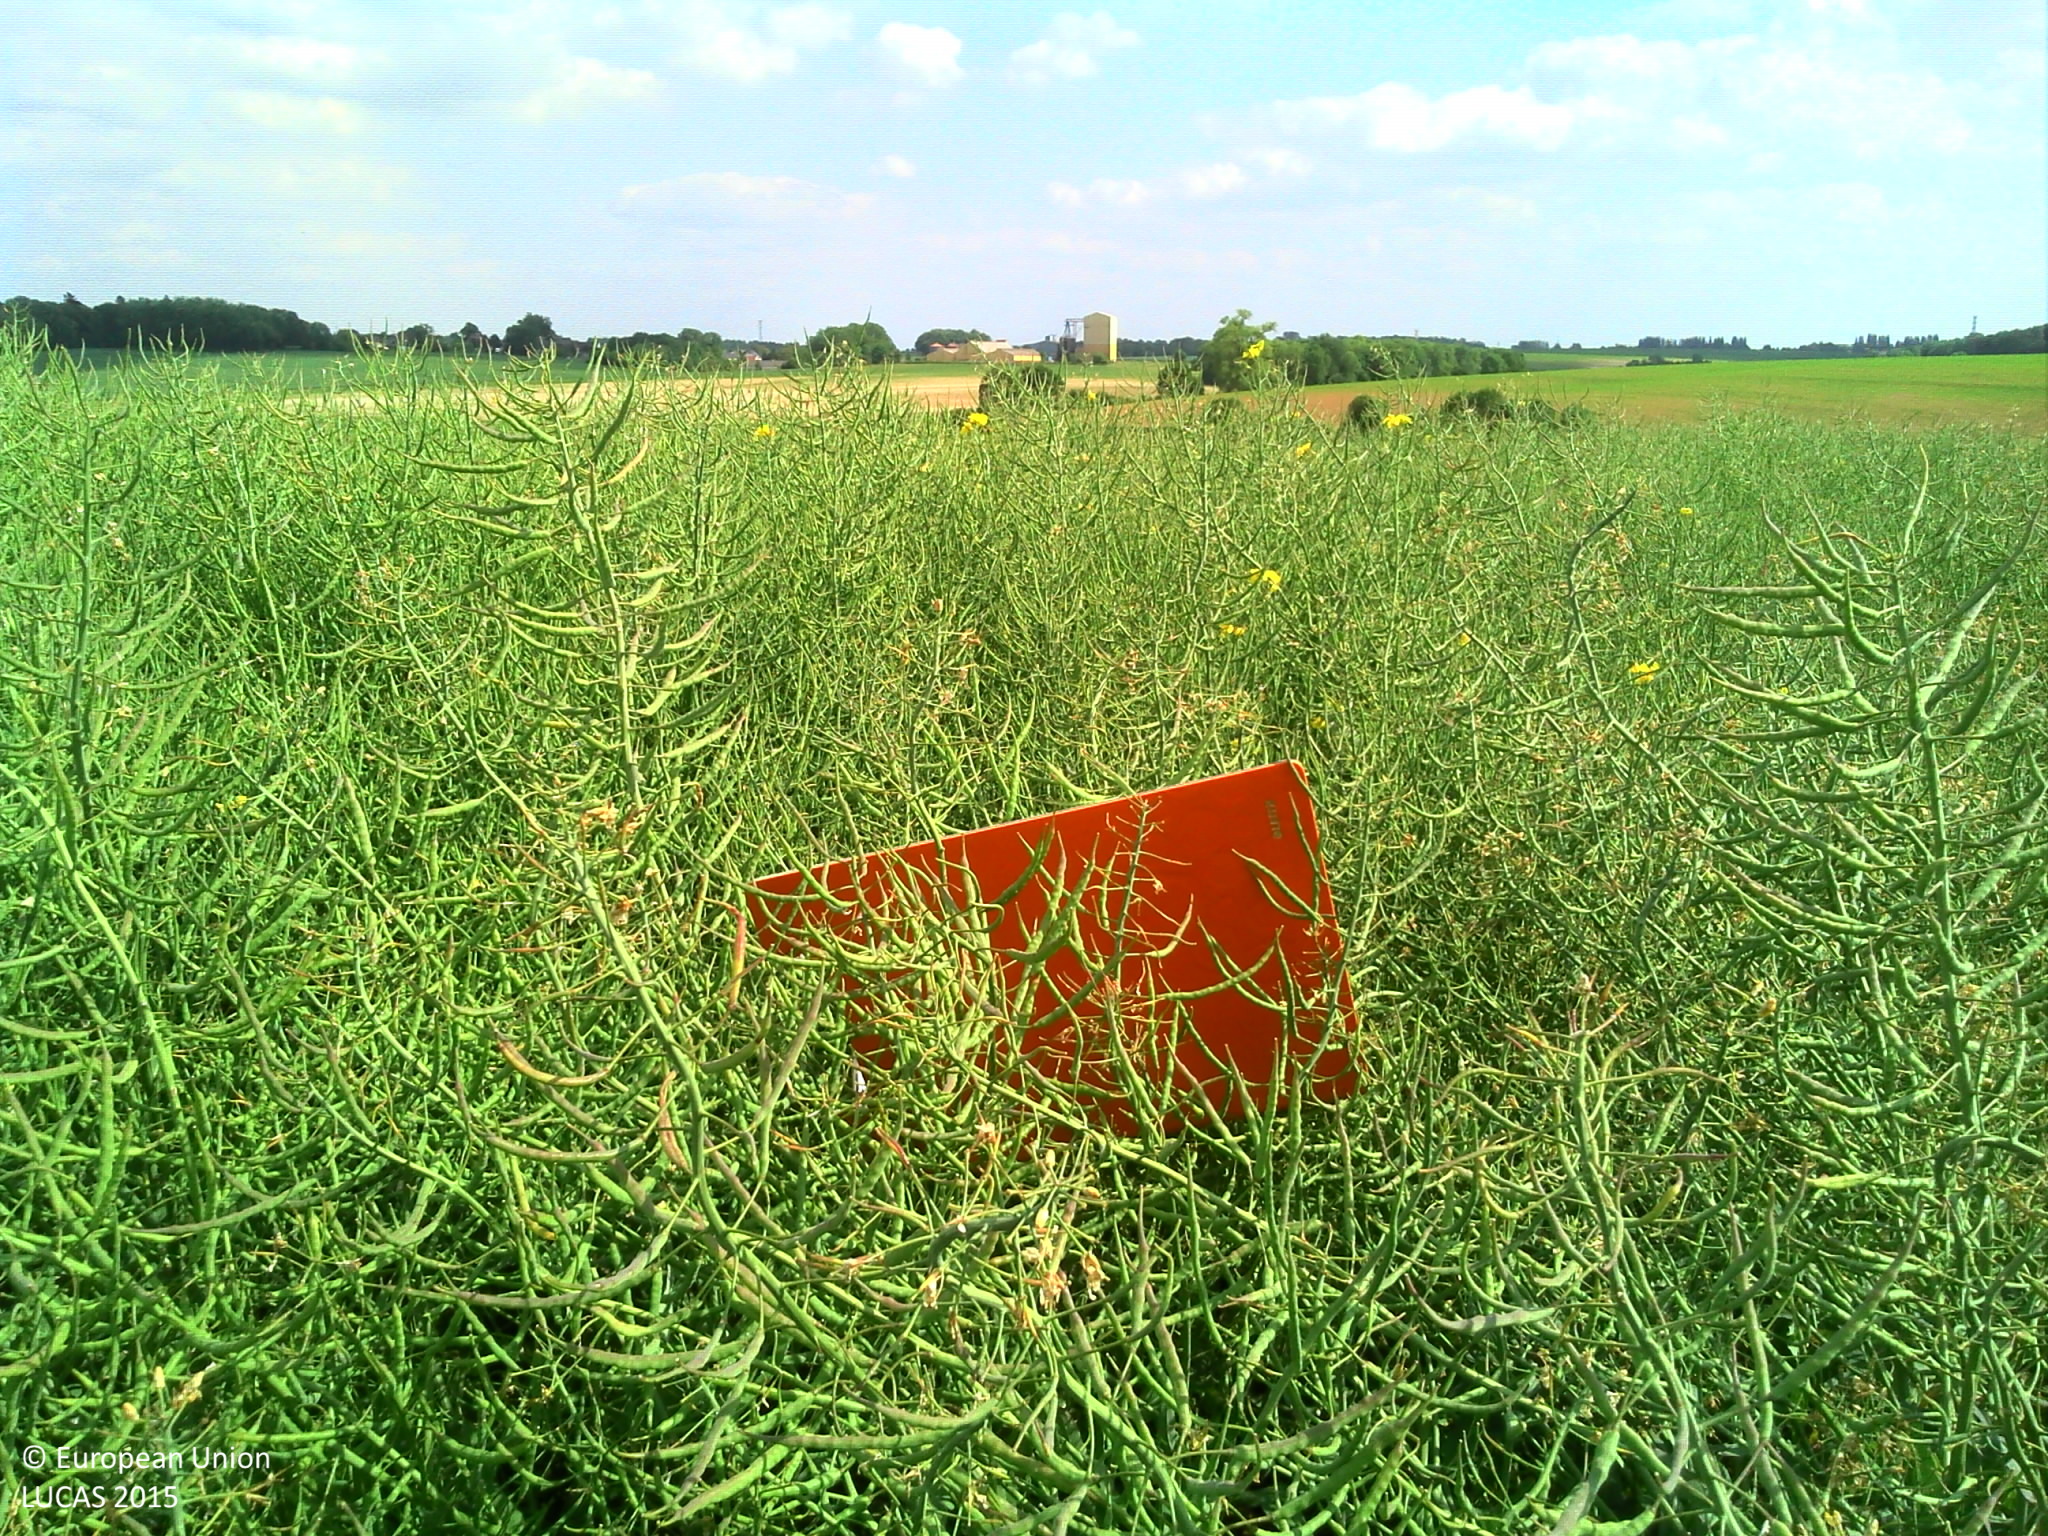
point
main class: Cropland
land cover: Rape and turnip rape
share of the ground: > 75 %
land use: Agriculture (excluding fallow land and kitchen gardens)
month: May
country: FR
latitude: 49.8917
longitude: 3.2124
